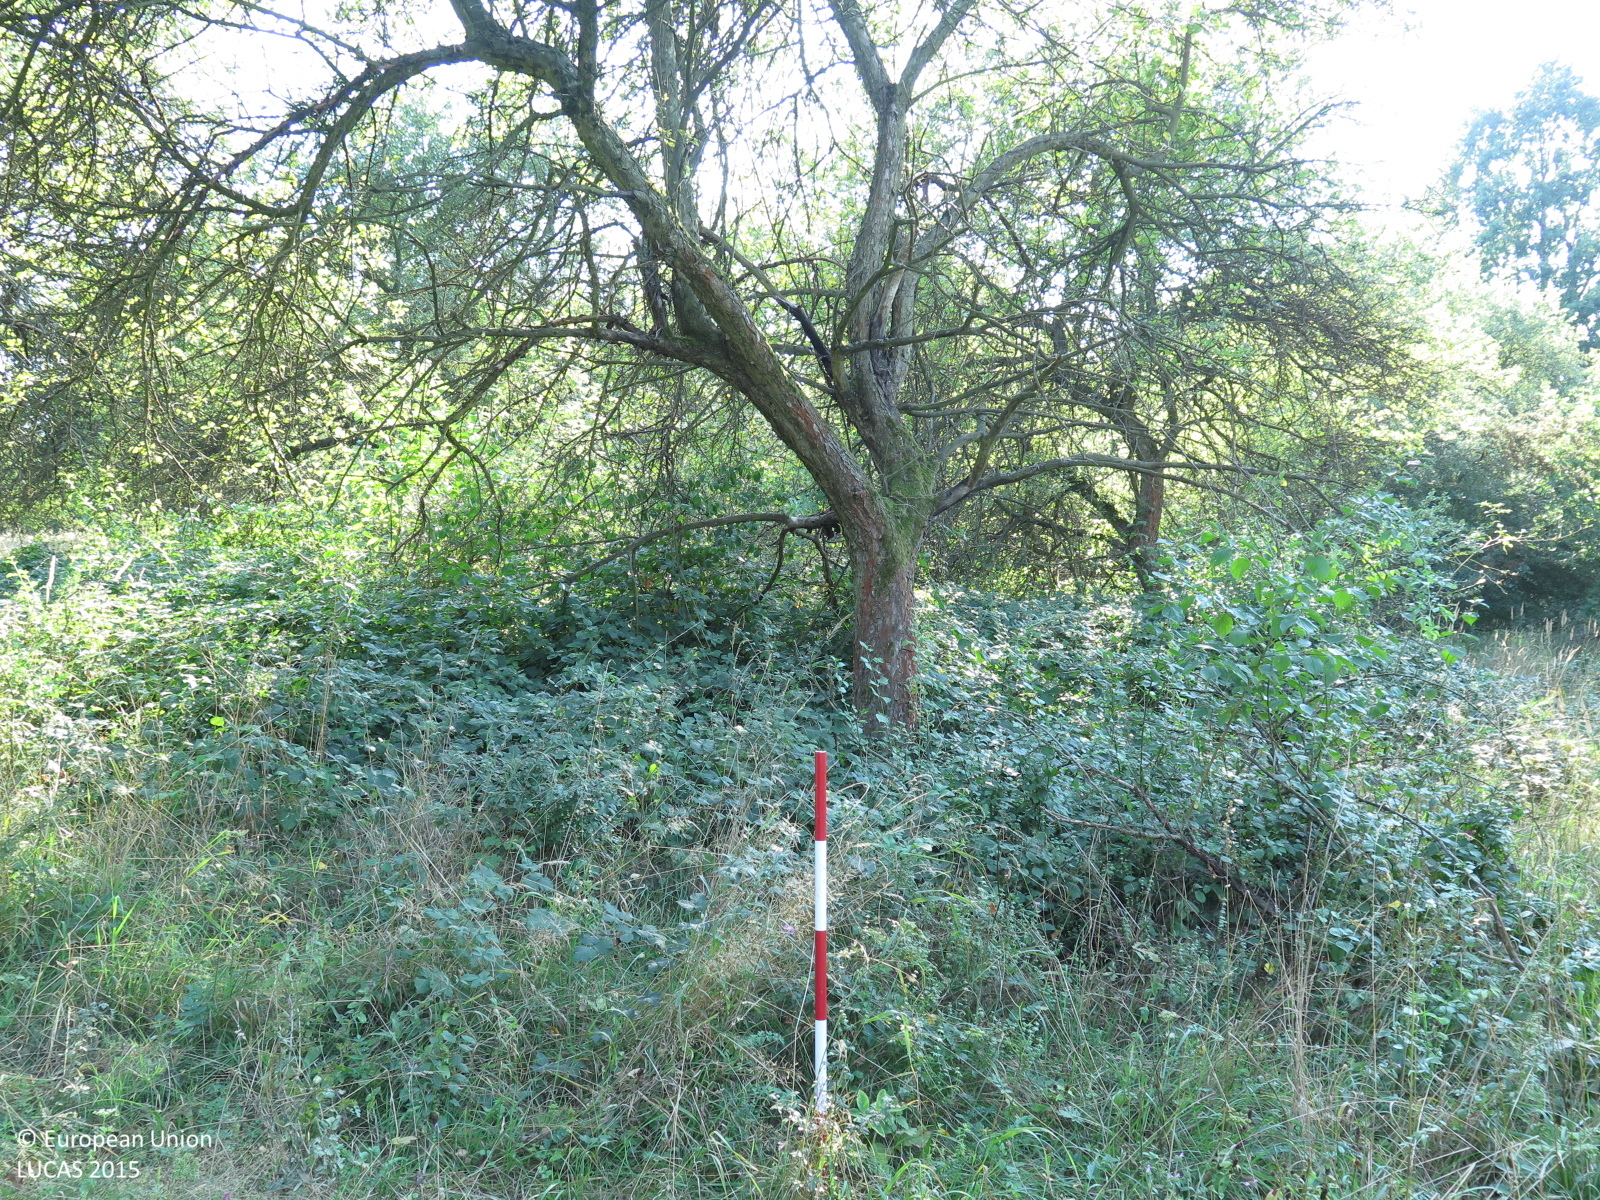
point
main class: Cropland
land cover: Apple fruit
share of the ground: 25 - 50 %
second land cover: Grassland without tree/shrub cover
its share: > 75 %
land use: Abandoned areas
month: September
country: CZ
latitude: 49.1916
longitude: 17.5727
